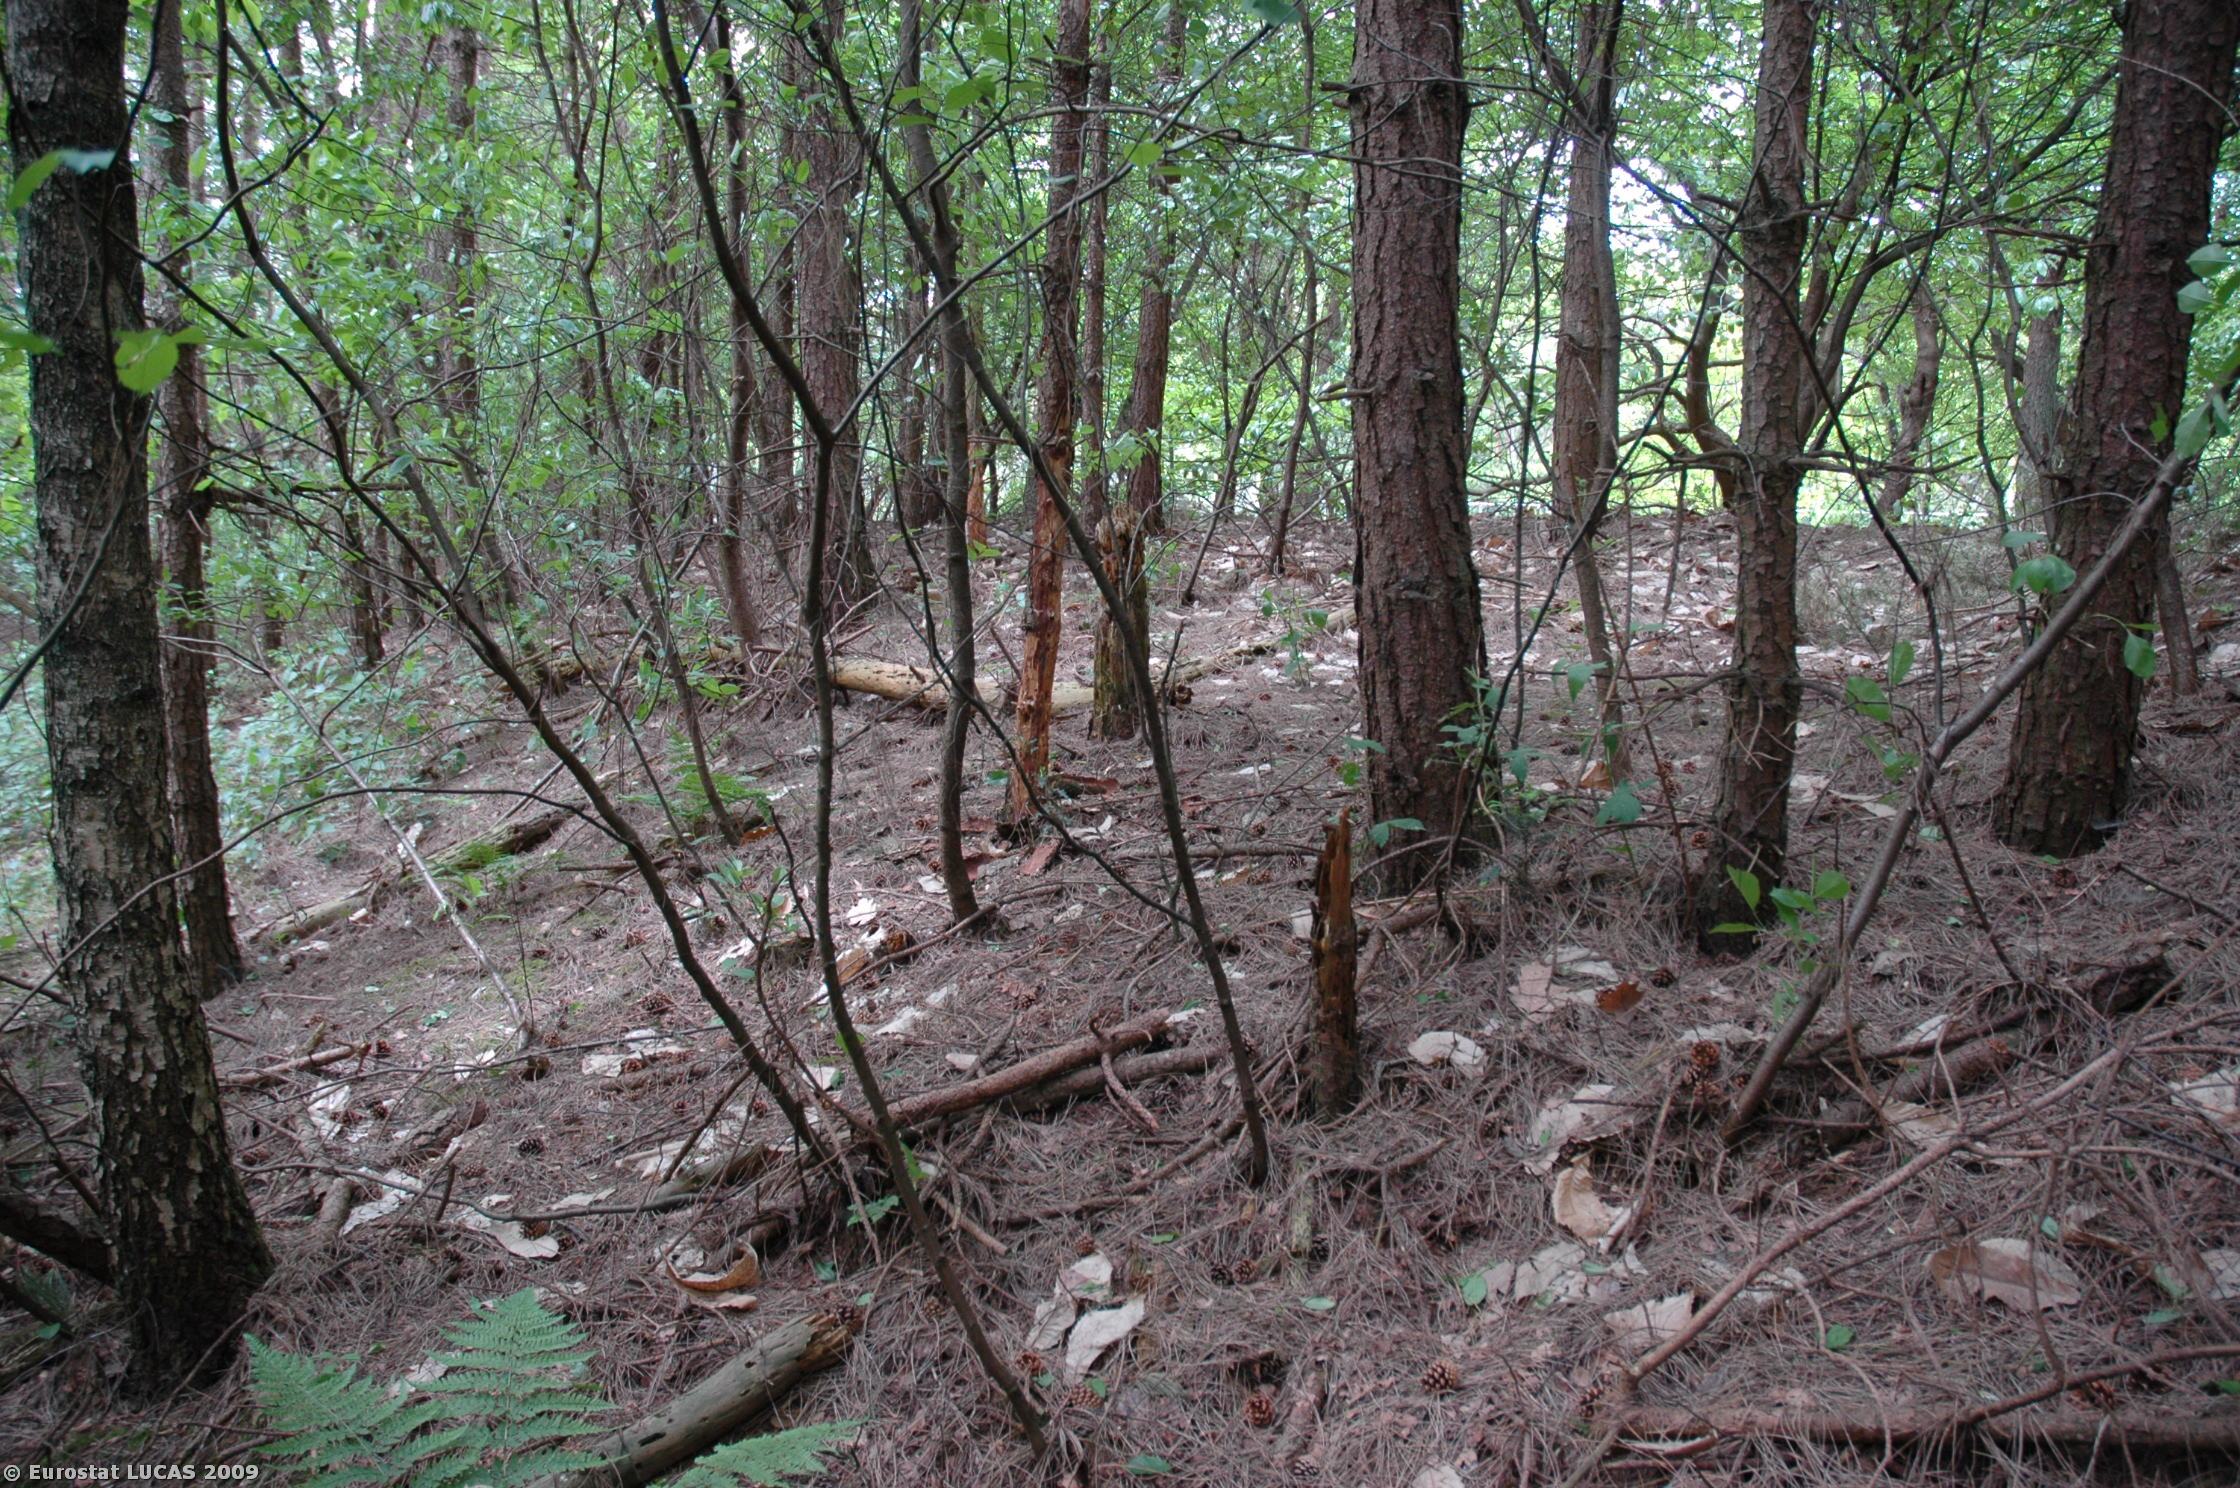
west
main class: Woodland
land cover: Mixed woodland
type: hemiboreal forest and nemoral coniferous forest and mixed broadleaved-coniferous forest
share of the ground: > 75 %
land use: Unused
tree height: > 5 m
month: May
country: NL
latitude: 52.0198
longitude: 5.4371
